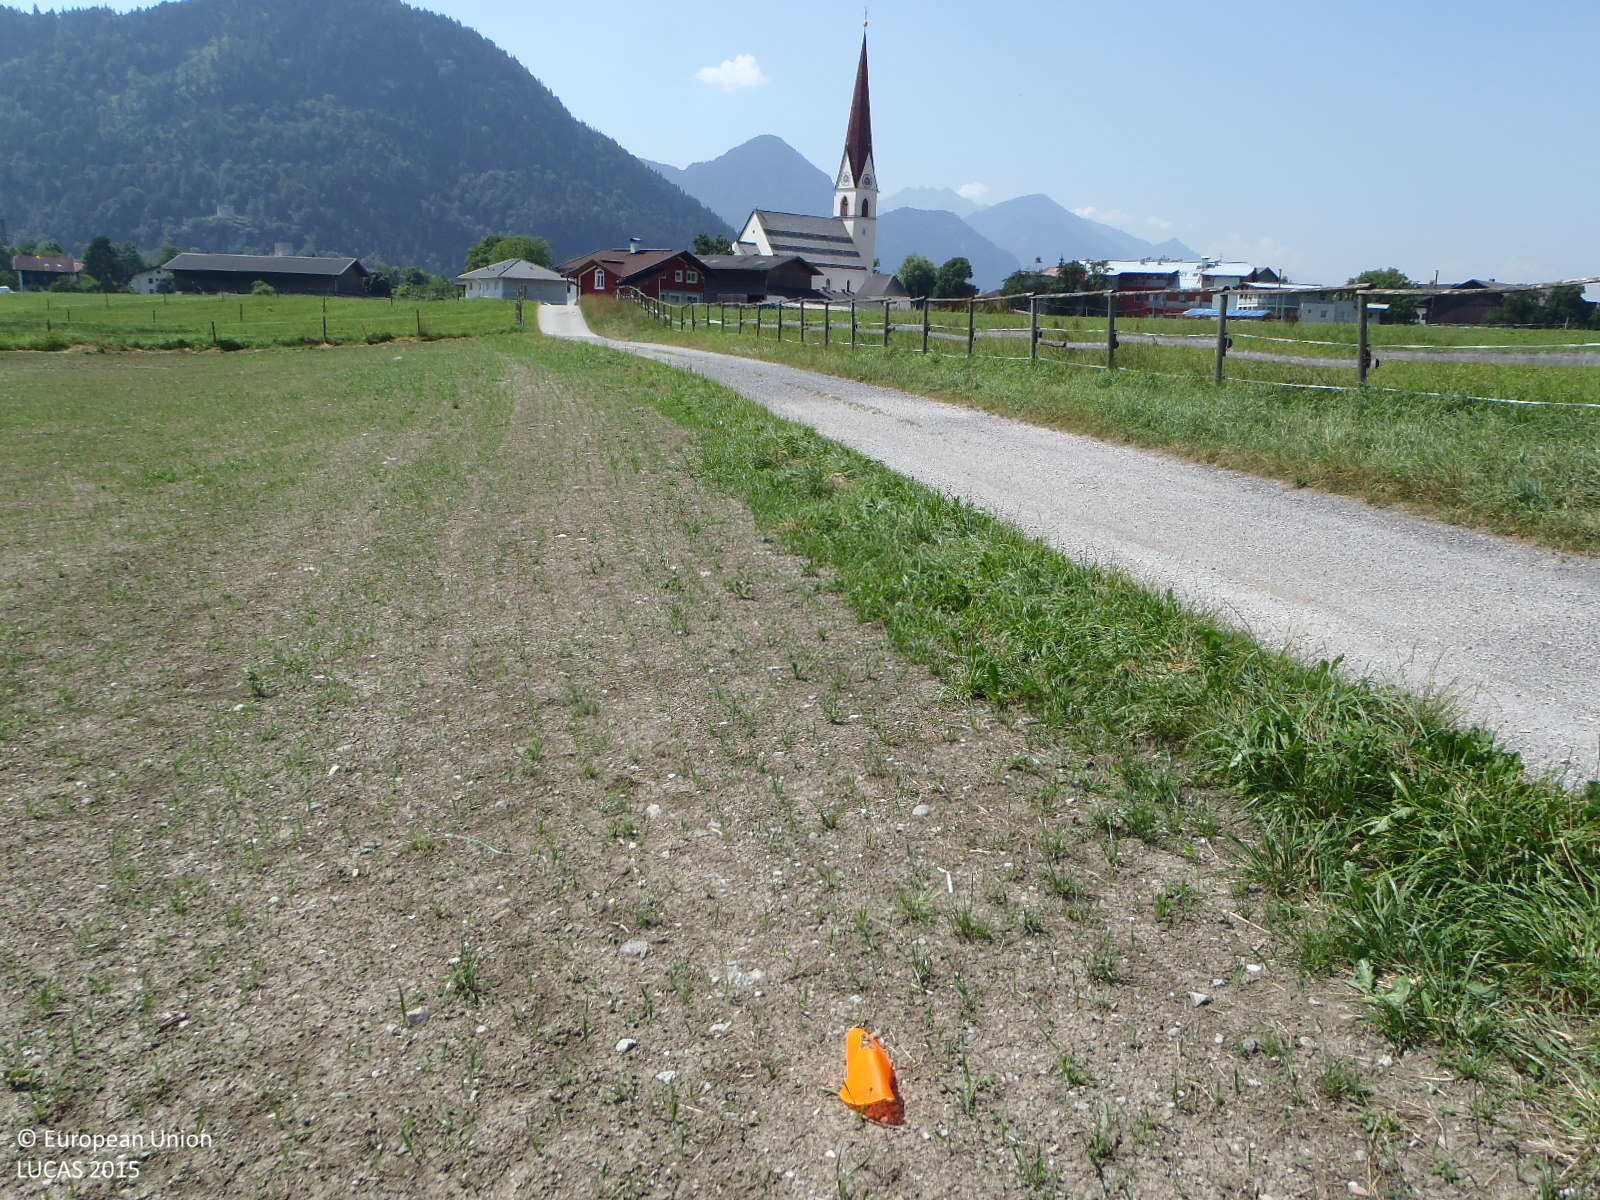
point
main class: Cropland
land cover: Oats
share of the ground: 10 - 25 %
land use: Agriculture (excluding fallow land and kitchen gardens)
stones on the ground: < 10 %
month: July
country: AT
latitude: 47.4511
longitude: 11.8951
